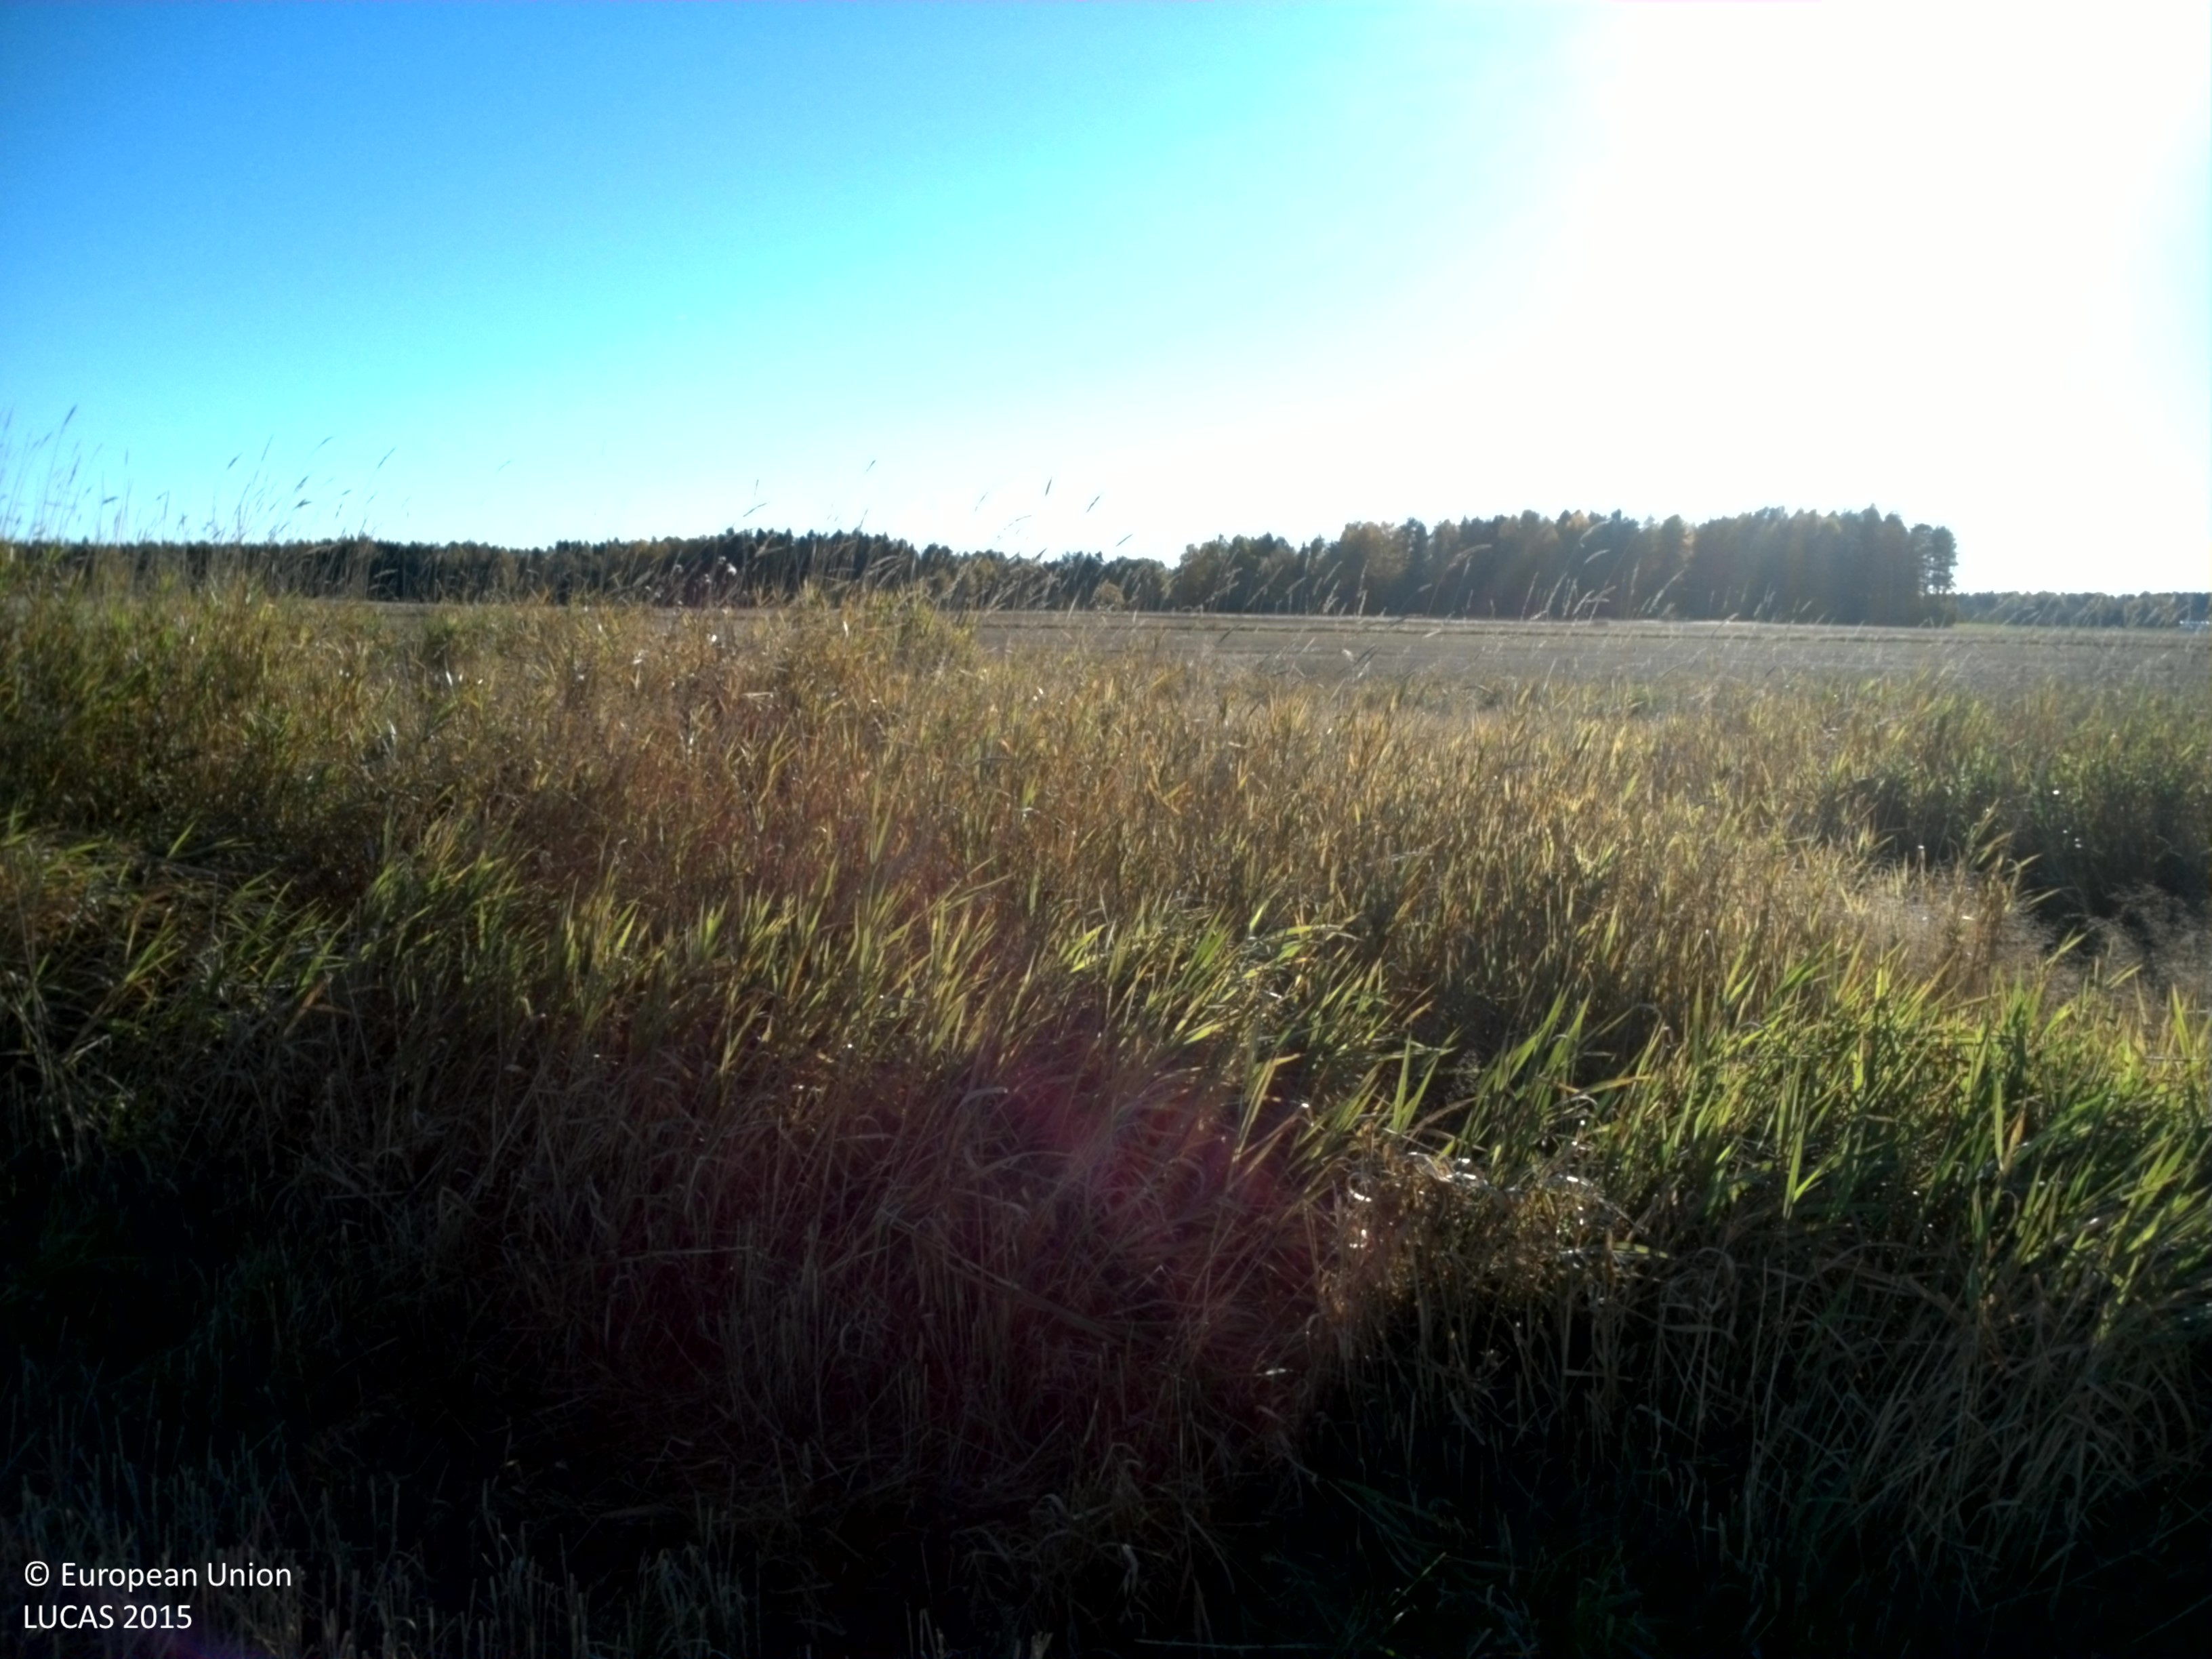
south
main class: Cropland
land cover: Common wheat
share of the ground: > 75 %
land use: Agriculture (excluding fallow land and kitchen gardens)
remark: Harvested field
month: October
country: SE
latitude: 59.0656
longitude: 13.1151
